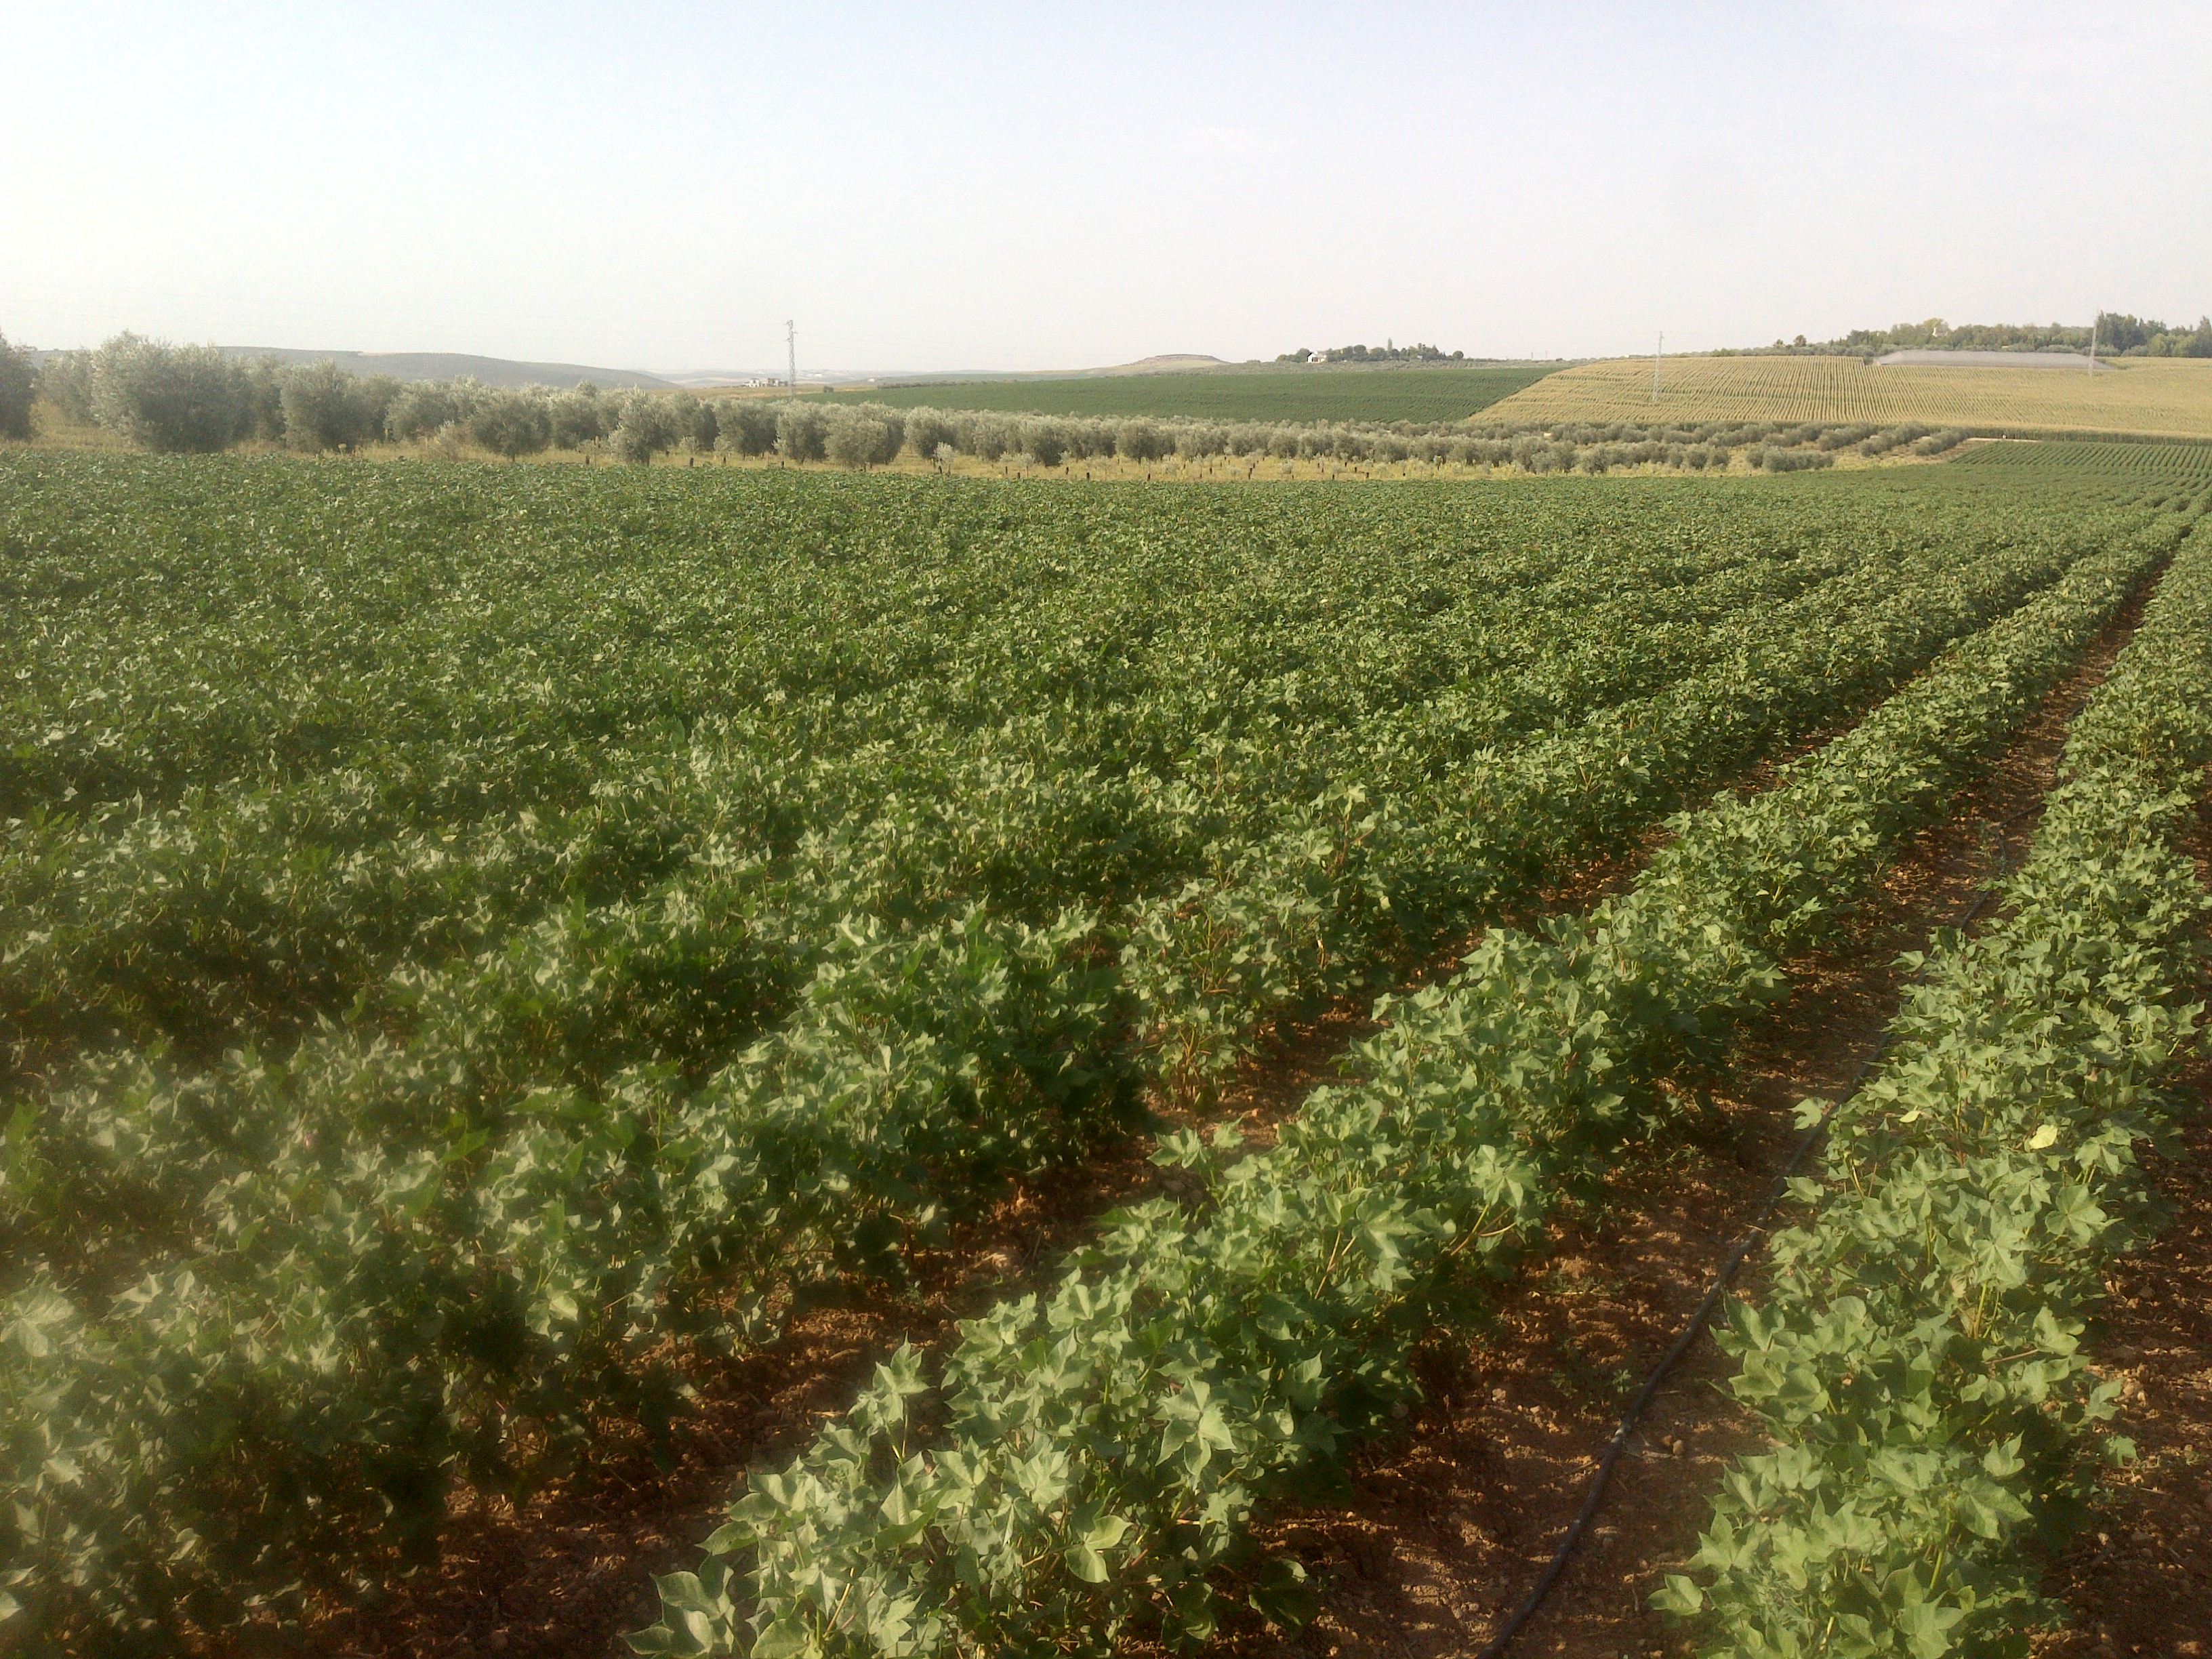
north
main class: Cropland
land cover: Cotton
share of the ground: 50 - 75 %
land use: Agriculture (excluding fallow land and kitchen gardens)
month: July
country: ES
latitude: 37.4397
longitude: -4.8478
